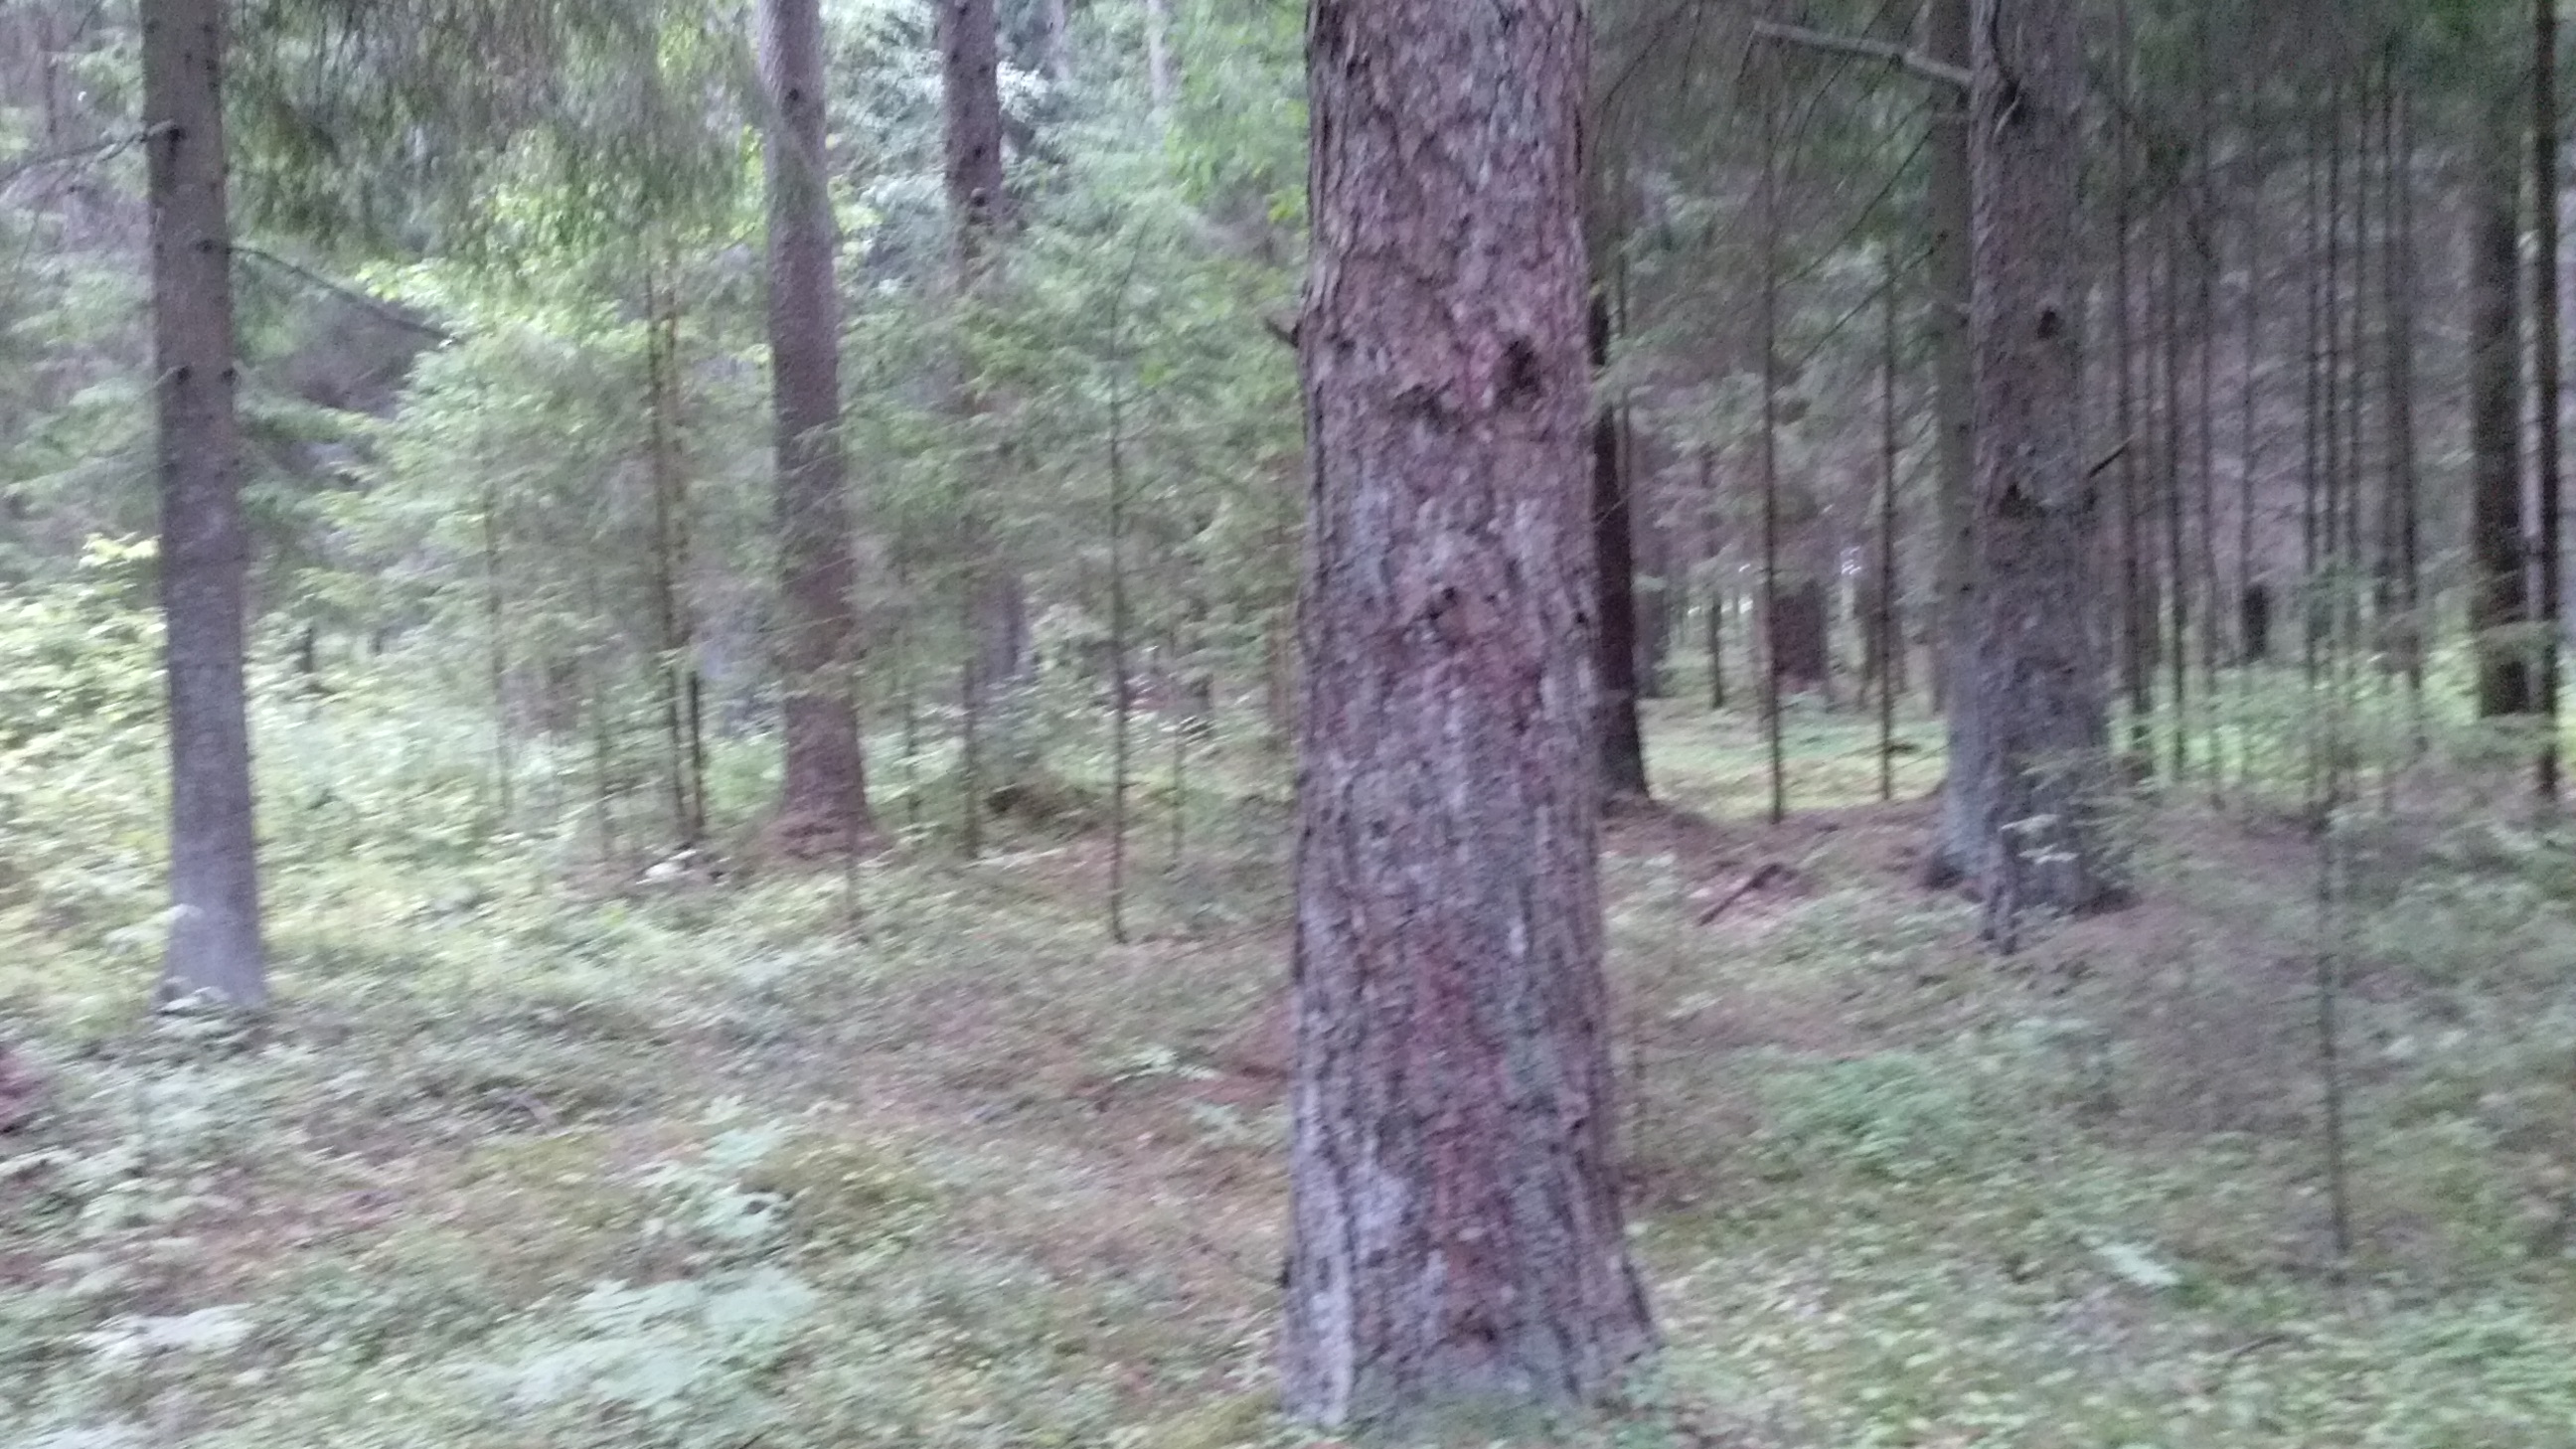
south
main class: Woodland
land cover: Spruce dominated coniferous woodland
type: hemiboreal forest and nemoral coniferous forest and mixed broadleaved-coniferous forest
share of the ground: > 75 %
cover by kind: coniferous forest trees 80 %, lichens and mosses 10 %, herbaceous plants 5 %, unconsolidated bare surface 5 %
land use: Forestry
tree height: > 5 m
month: July
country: LV
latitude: 56.5124
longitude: 26.8812
